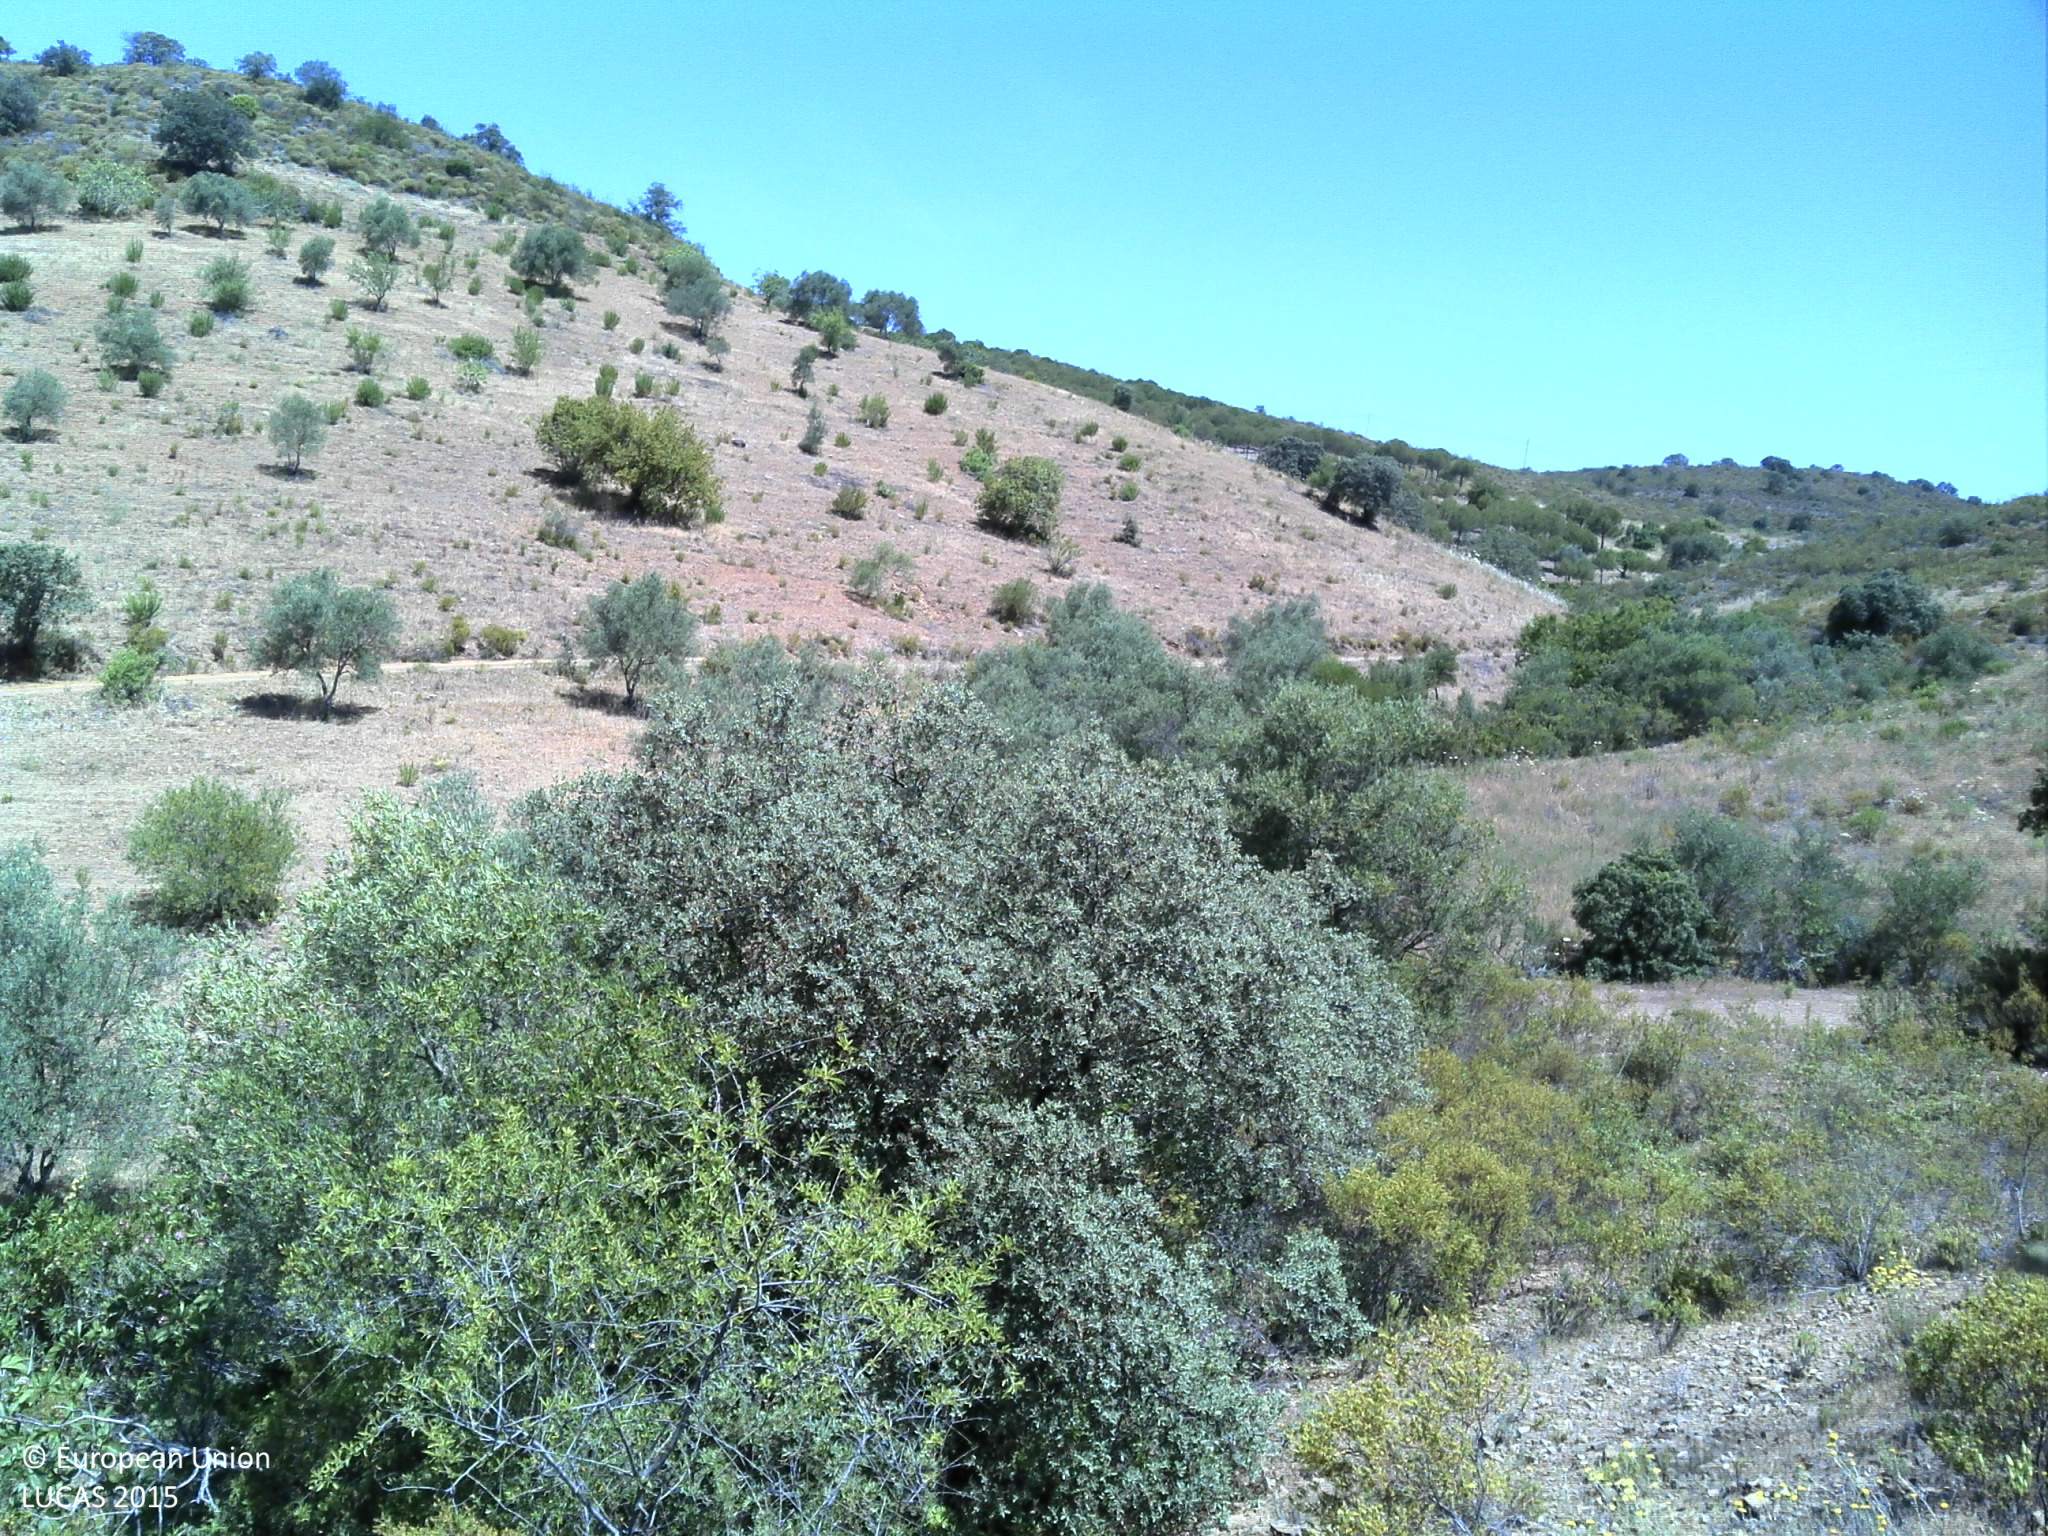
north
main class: Cropland
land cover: Nuts trees
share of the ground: 10 - 25 %
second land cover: Shrubland without tree cover
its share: 50 - 75 %
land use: Agriculture (excluding fallow land and kitchen gardens)
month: May
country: PT
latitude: 37.3910
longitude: -7.4801
